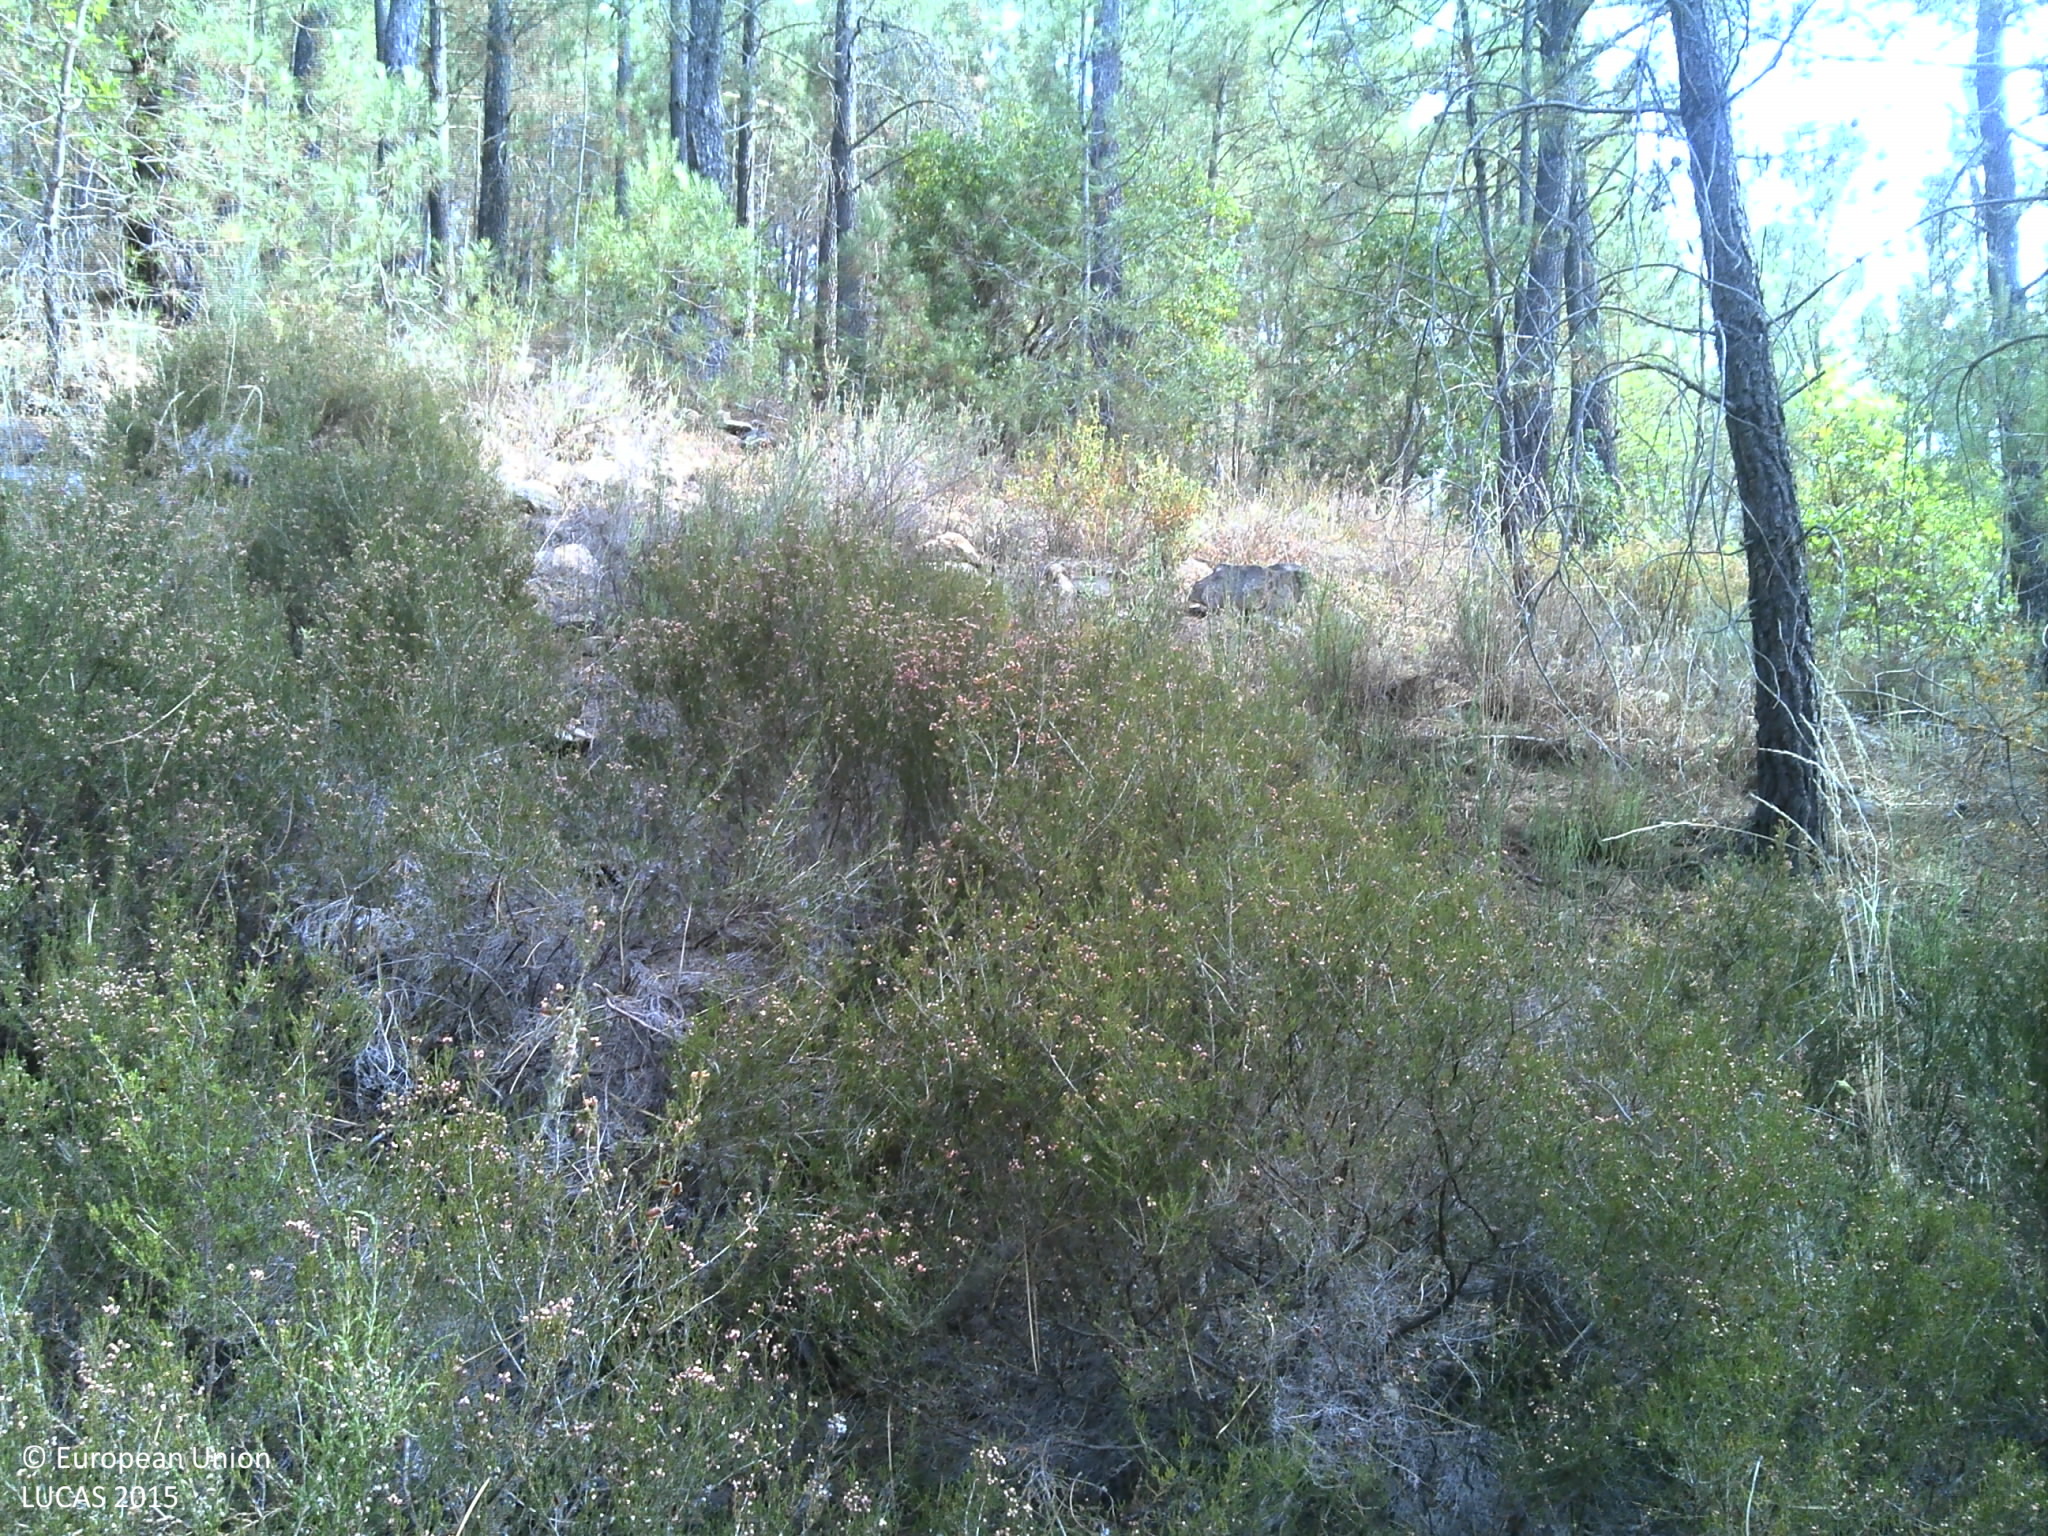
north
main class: Woodland
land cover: Pine dominated coniferous woodland
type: coniferous forest of the mediterranean region
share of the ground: 50 - 75 %
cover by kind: coniferous forest trees 60 %, unconsolidated bare surface 25 %, shrubs 15 %
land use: Forestry
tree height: > 5 m
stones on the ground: 10 - 25 %
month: June
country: PT
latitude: 41.2614
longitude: -7.5143
